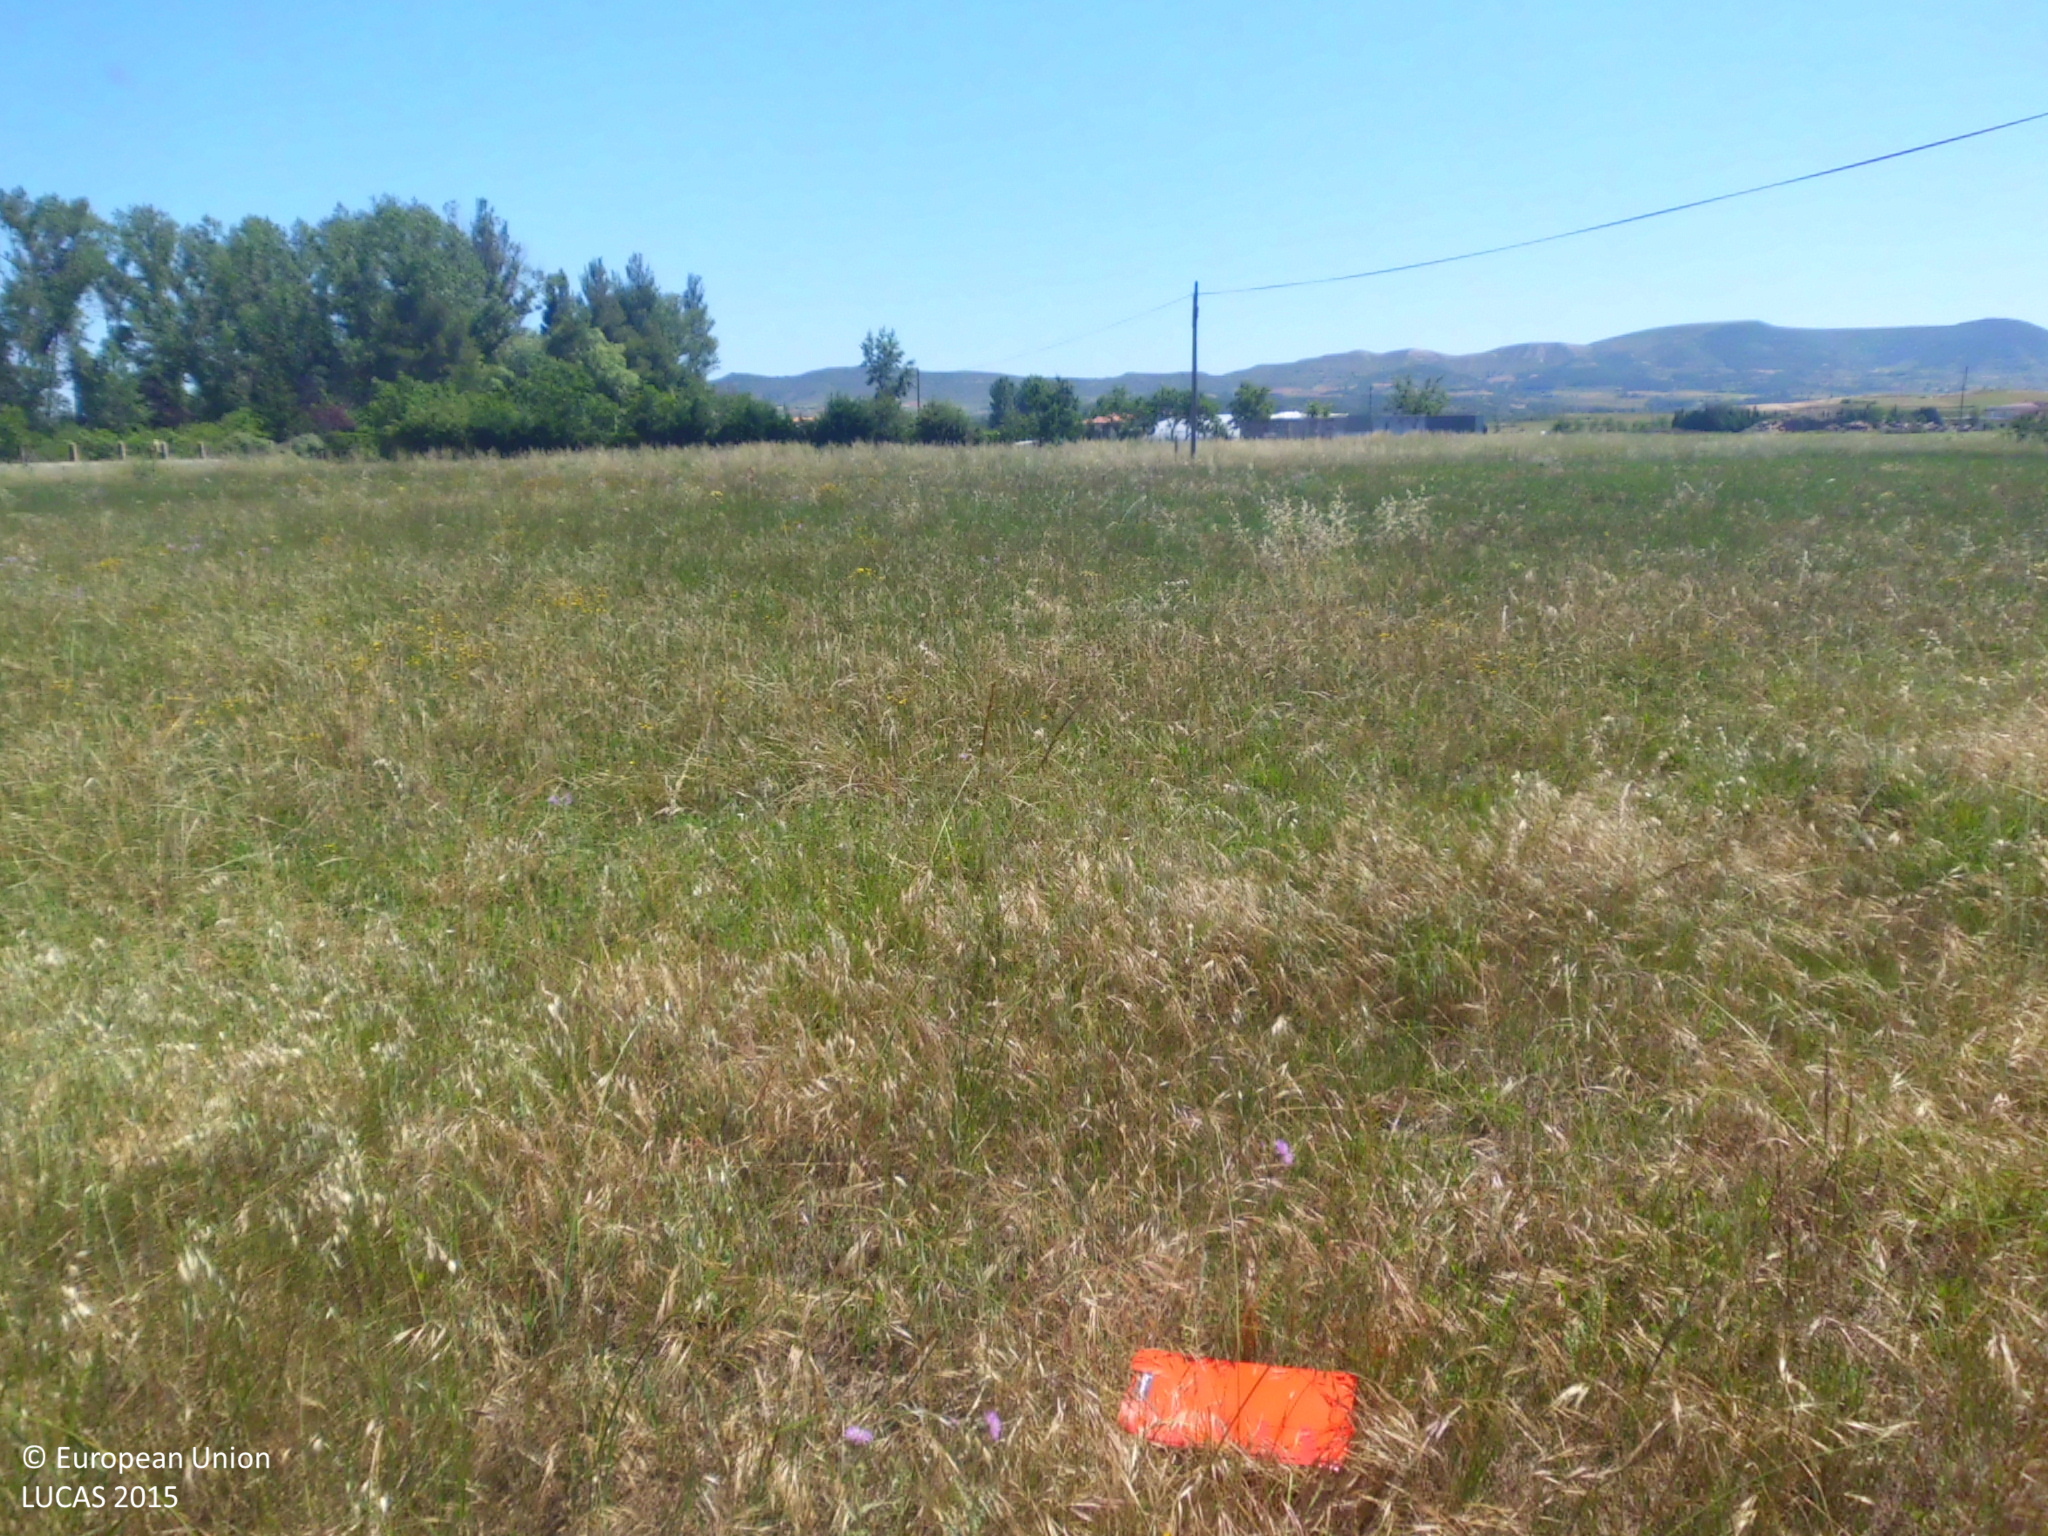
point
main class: Grassland
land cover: Grassland without tree/shrub cover
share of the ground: > 75 %
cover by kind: herbaceous plants 100 %
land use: Agriculture (excluding fallow land and kitchen gardens)
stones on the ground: 25 - 50 %
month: June
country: ES
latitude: 42.9153
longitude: -3.5018
